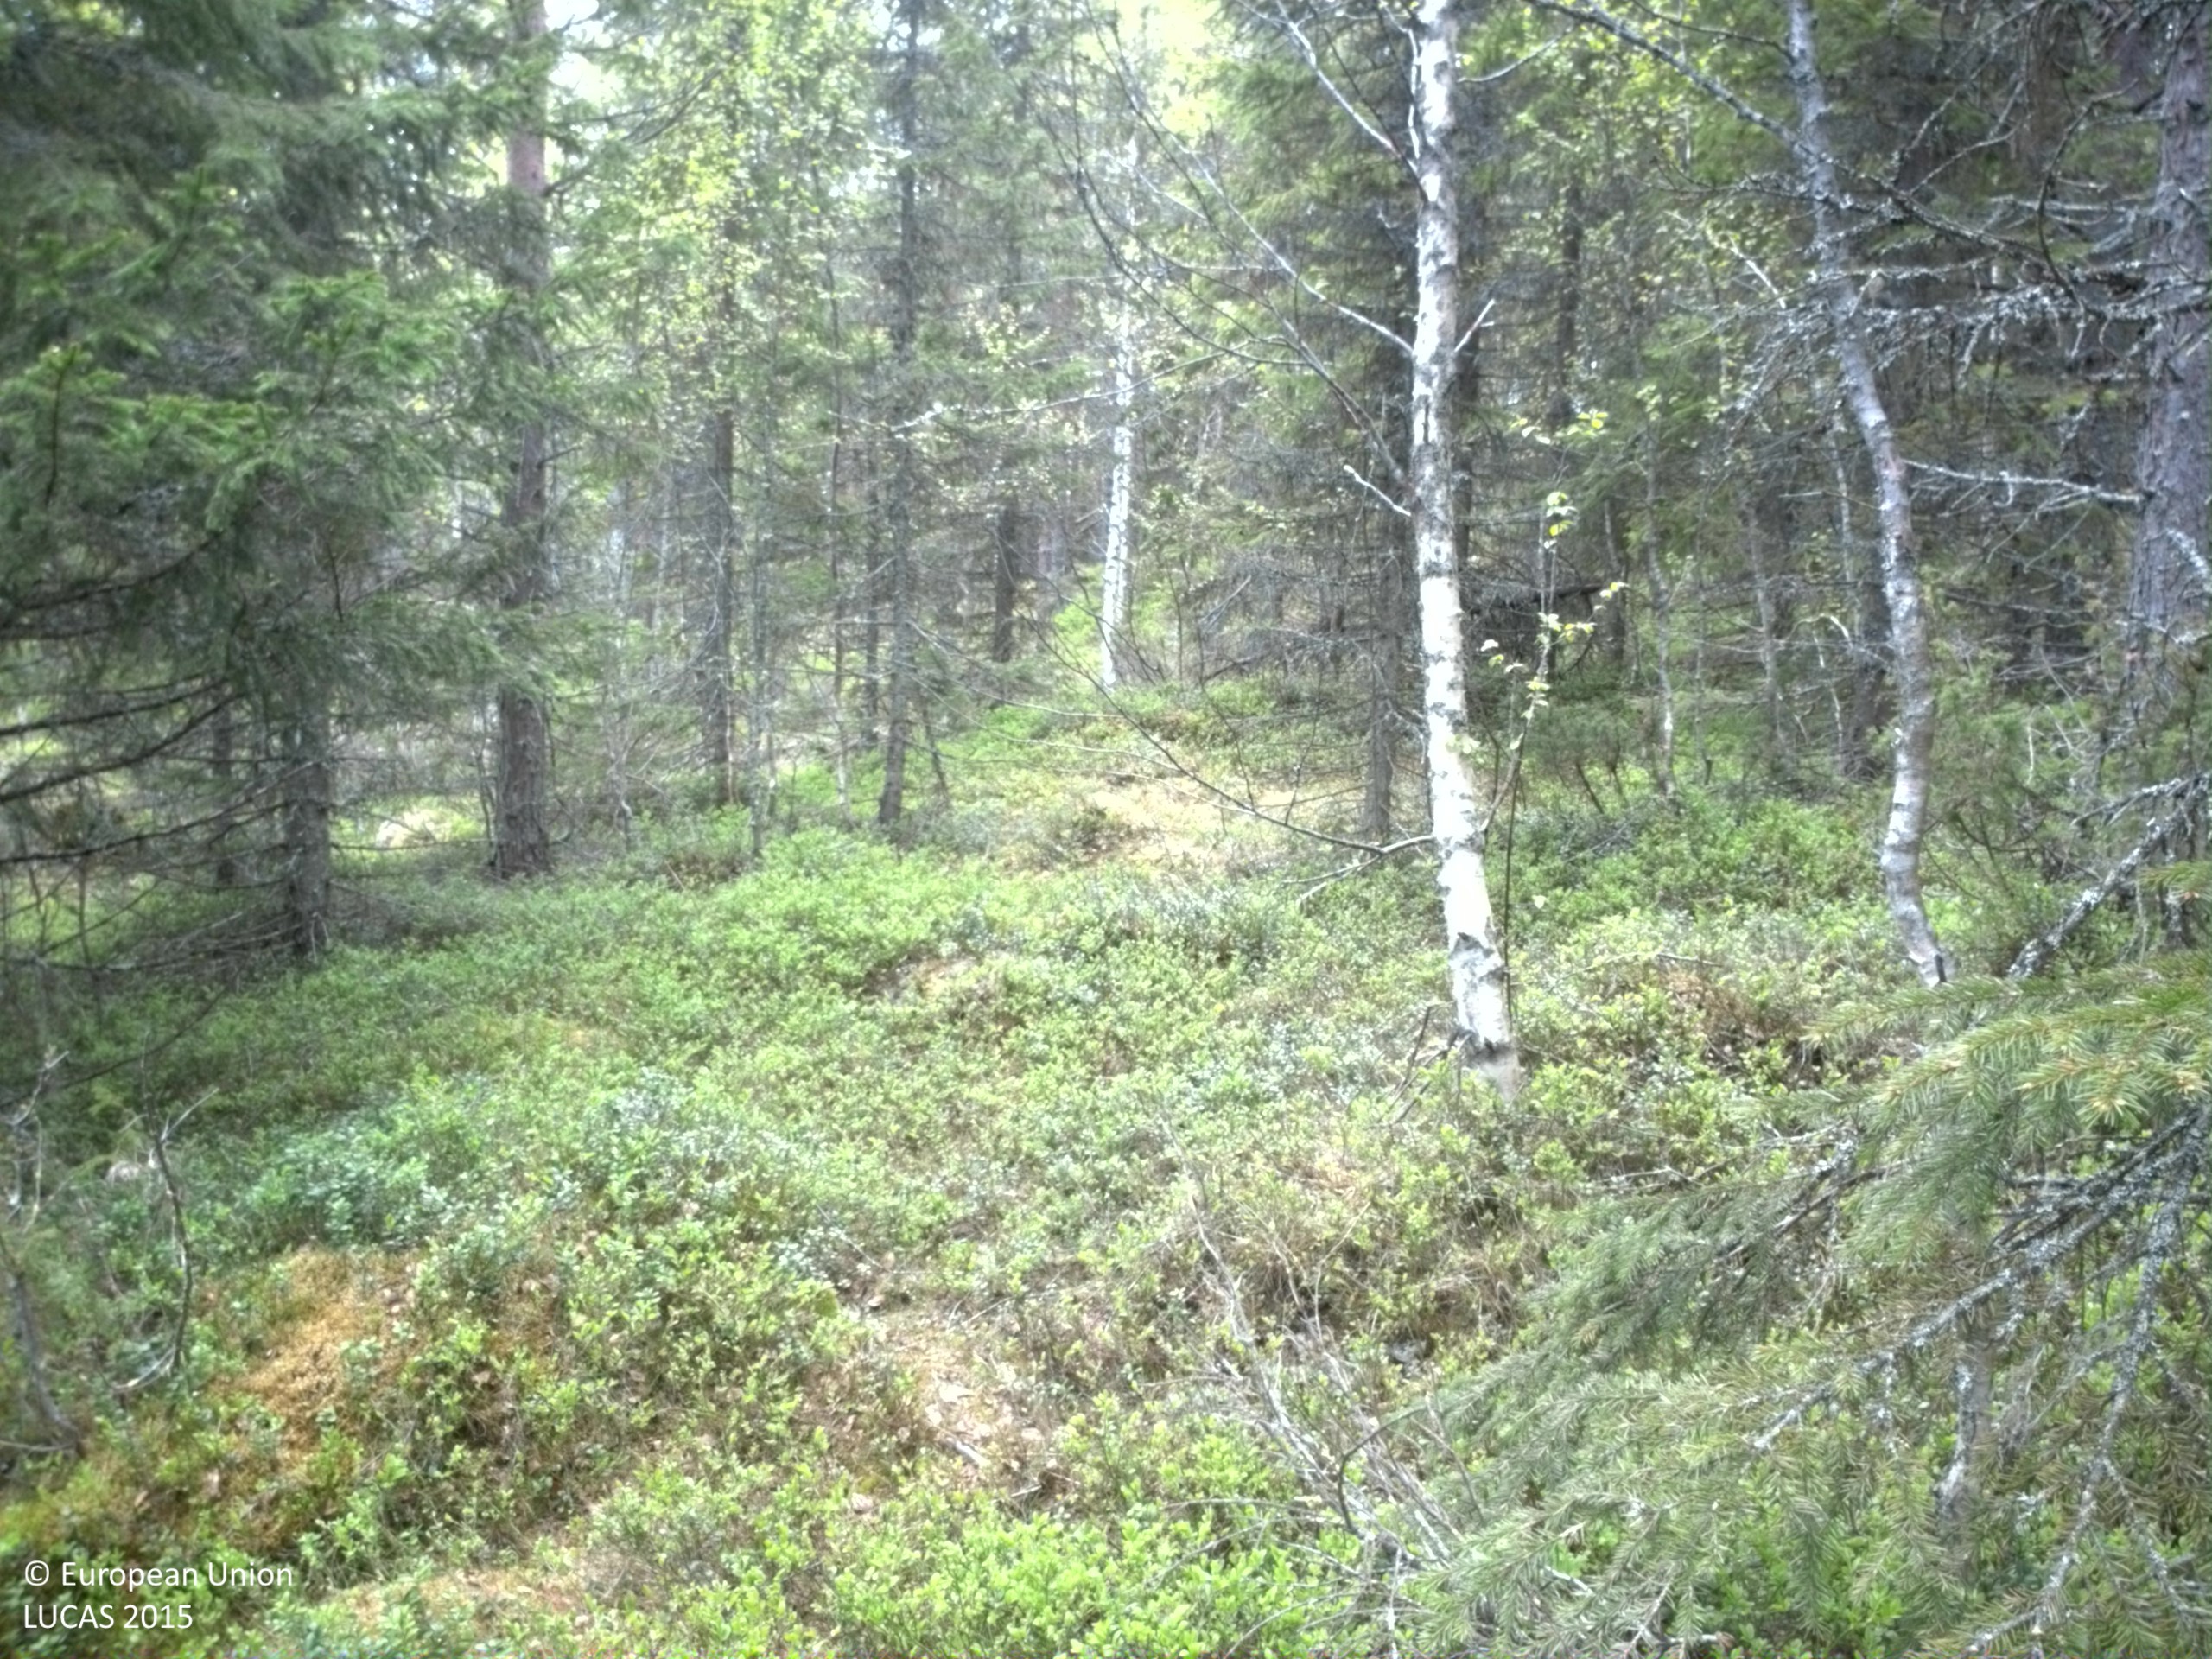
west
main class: Woodland
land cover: Spruce dominated mixed woodland
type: boreal forest
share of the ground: > 75 %
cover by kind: coniferous forest trees 60 %, broadleaved forest trees 20 %, shrubs 10 %, lichens and mosses 10 %
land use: Forestry
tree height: > 5 m
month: June
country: SE
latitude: 62.9432
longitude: 17.2879
